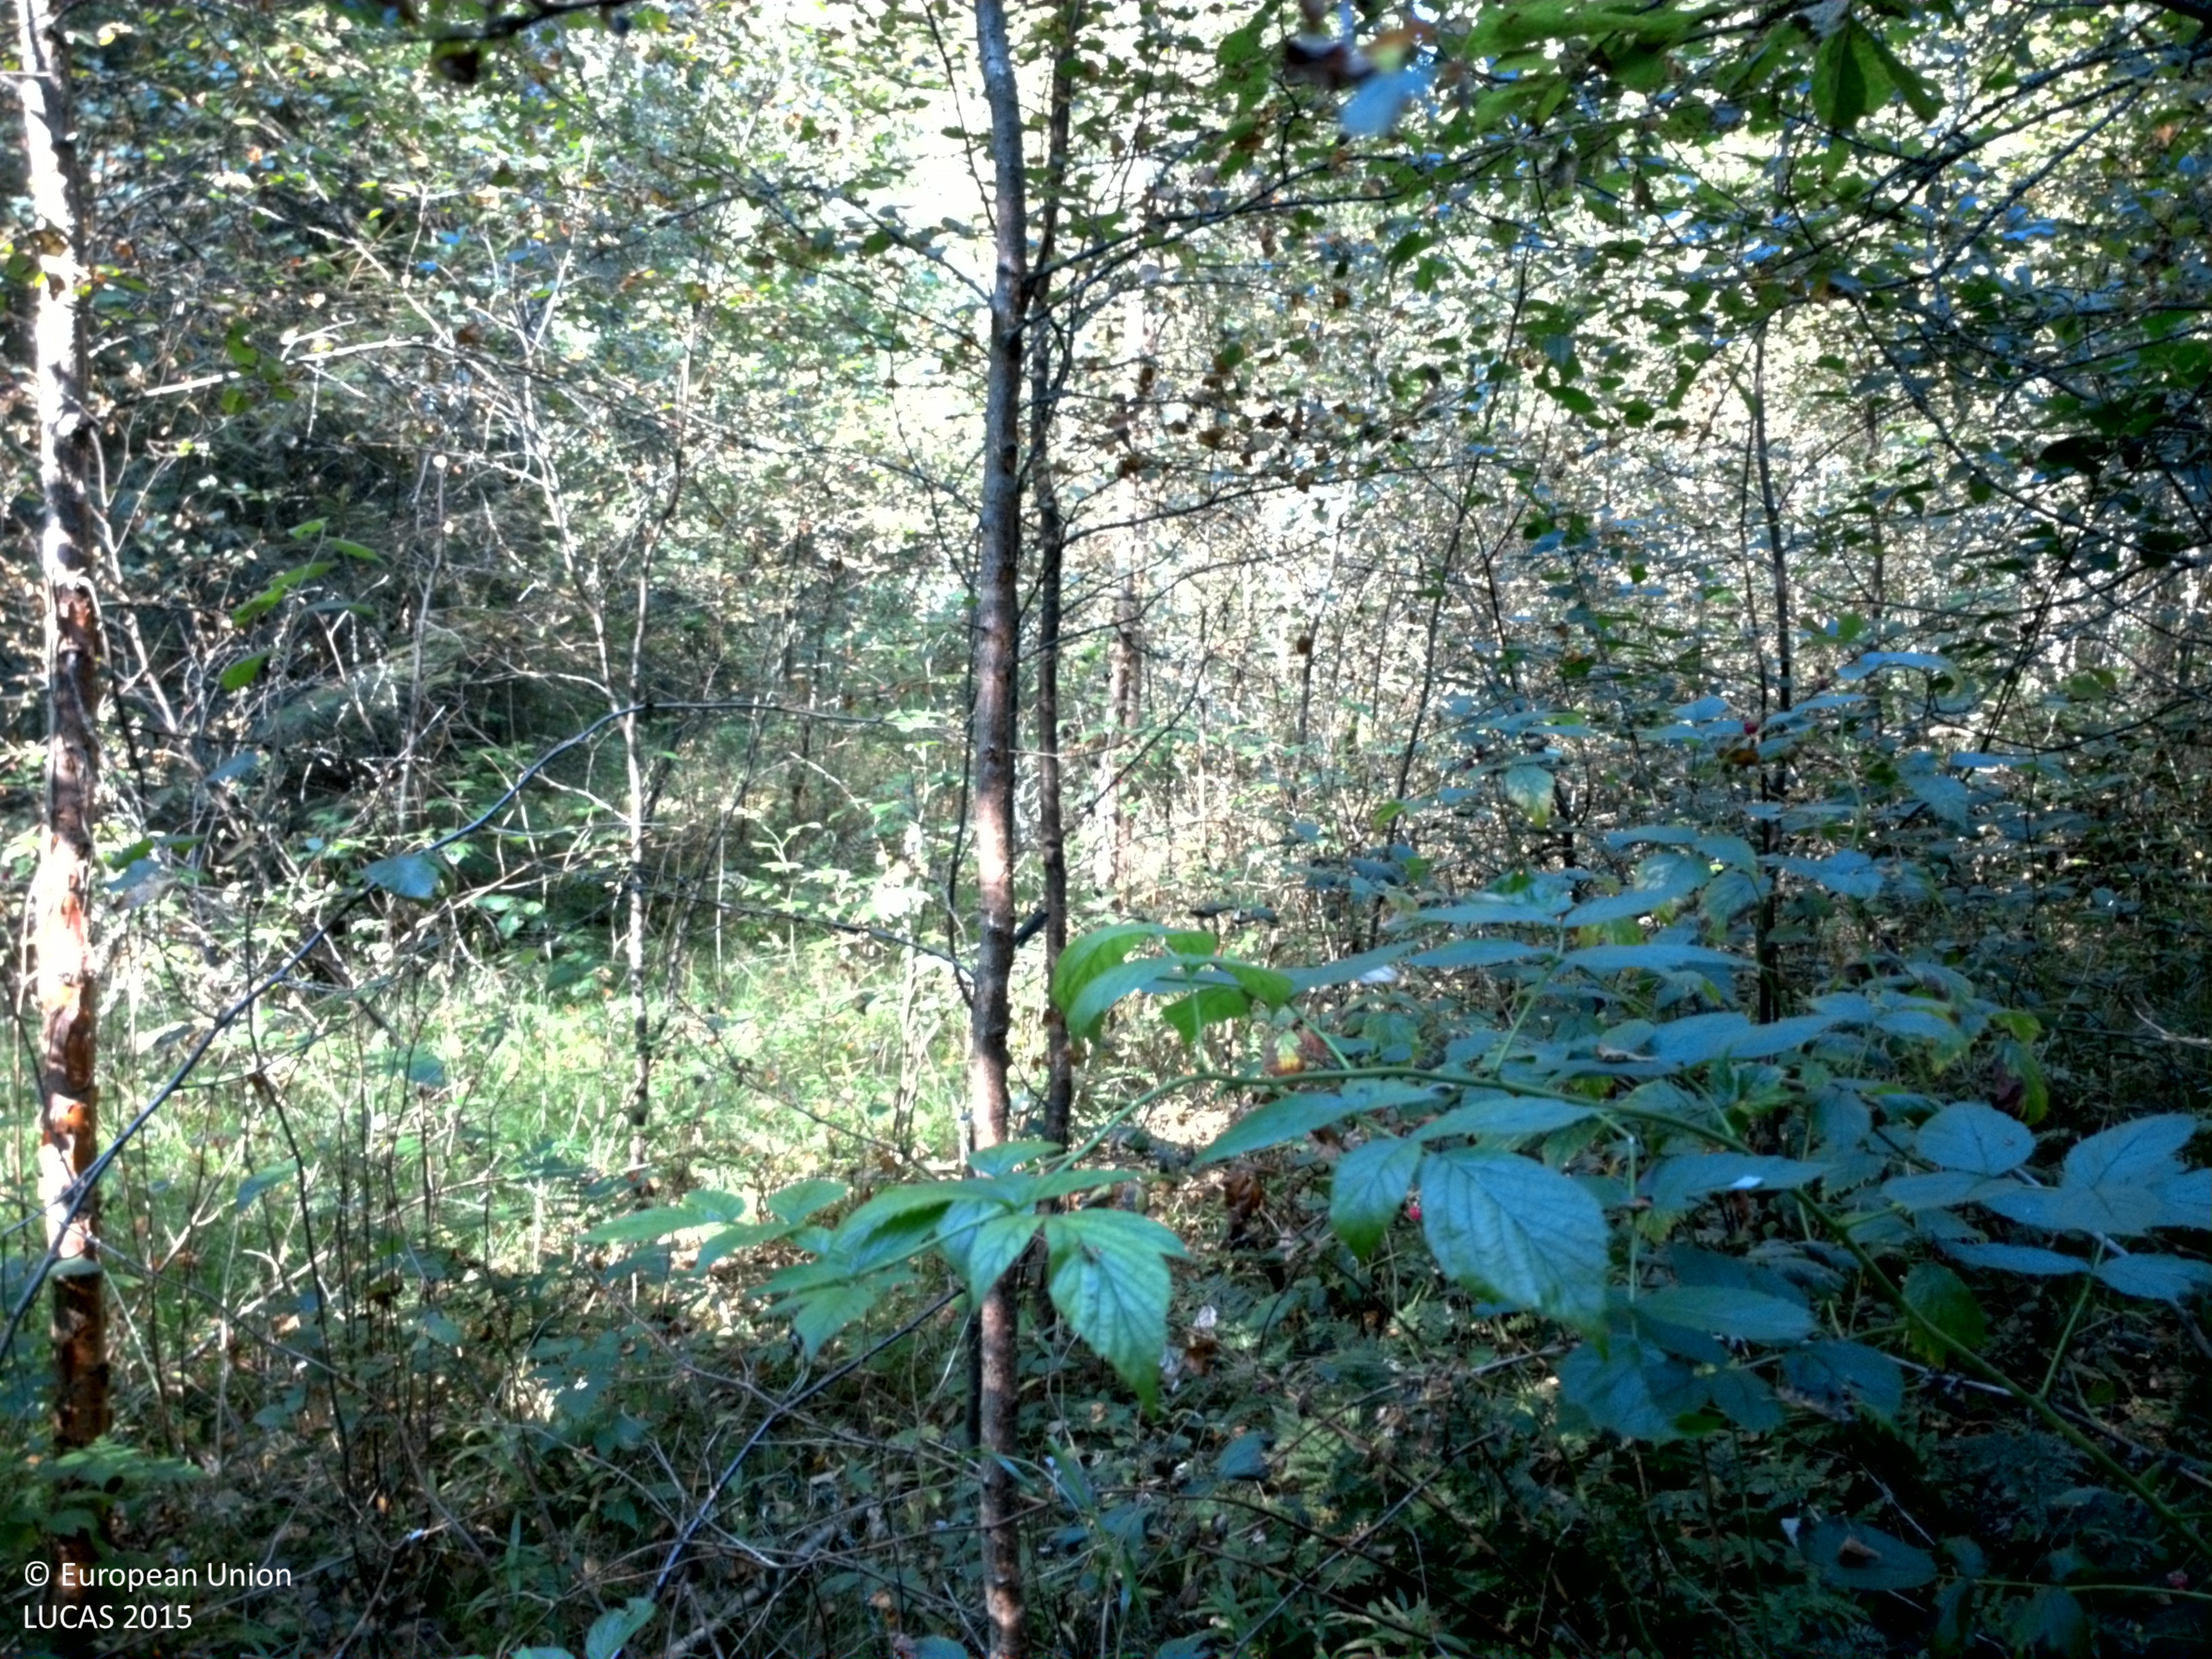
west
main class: Woodland
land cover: Broadleaved woodland
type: boreal forest
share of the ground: 25 - 50 %
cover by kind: broadleaved forest trees 45 %, shrubs 30 %, herbaceous plants 20 %, lichens and mosses 5 %
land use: Forestry
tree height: > 5 m
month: August
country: SE
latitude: 59.4543
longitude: 13.4320
